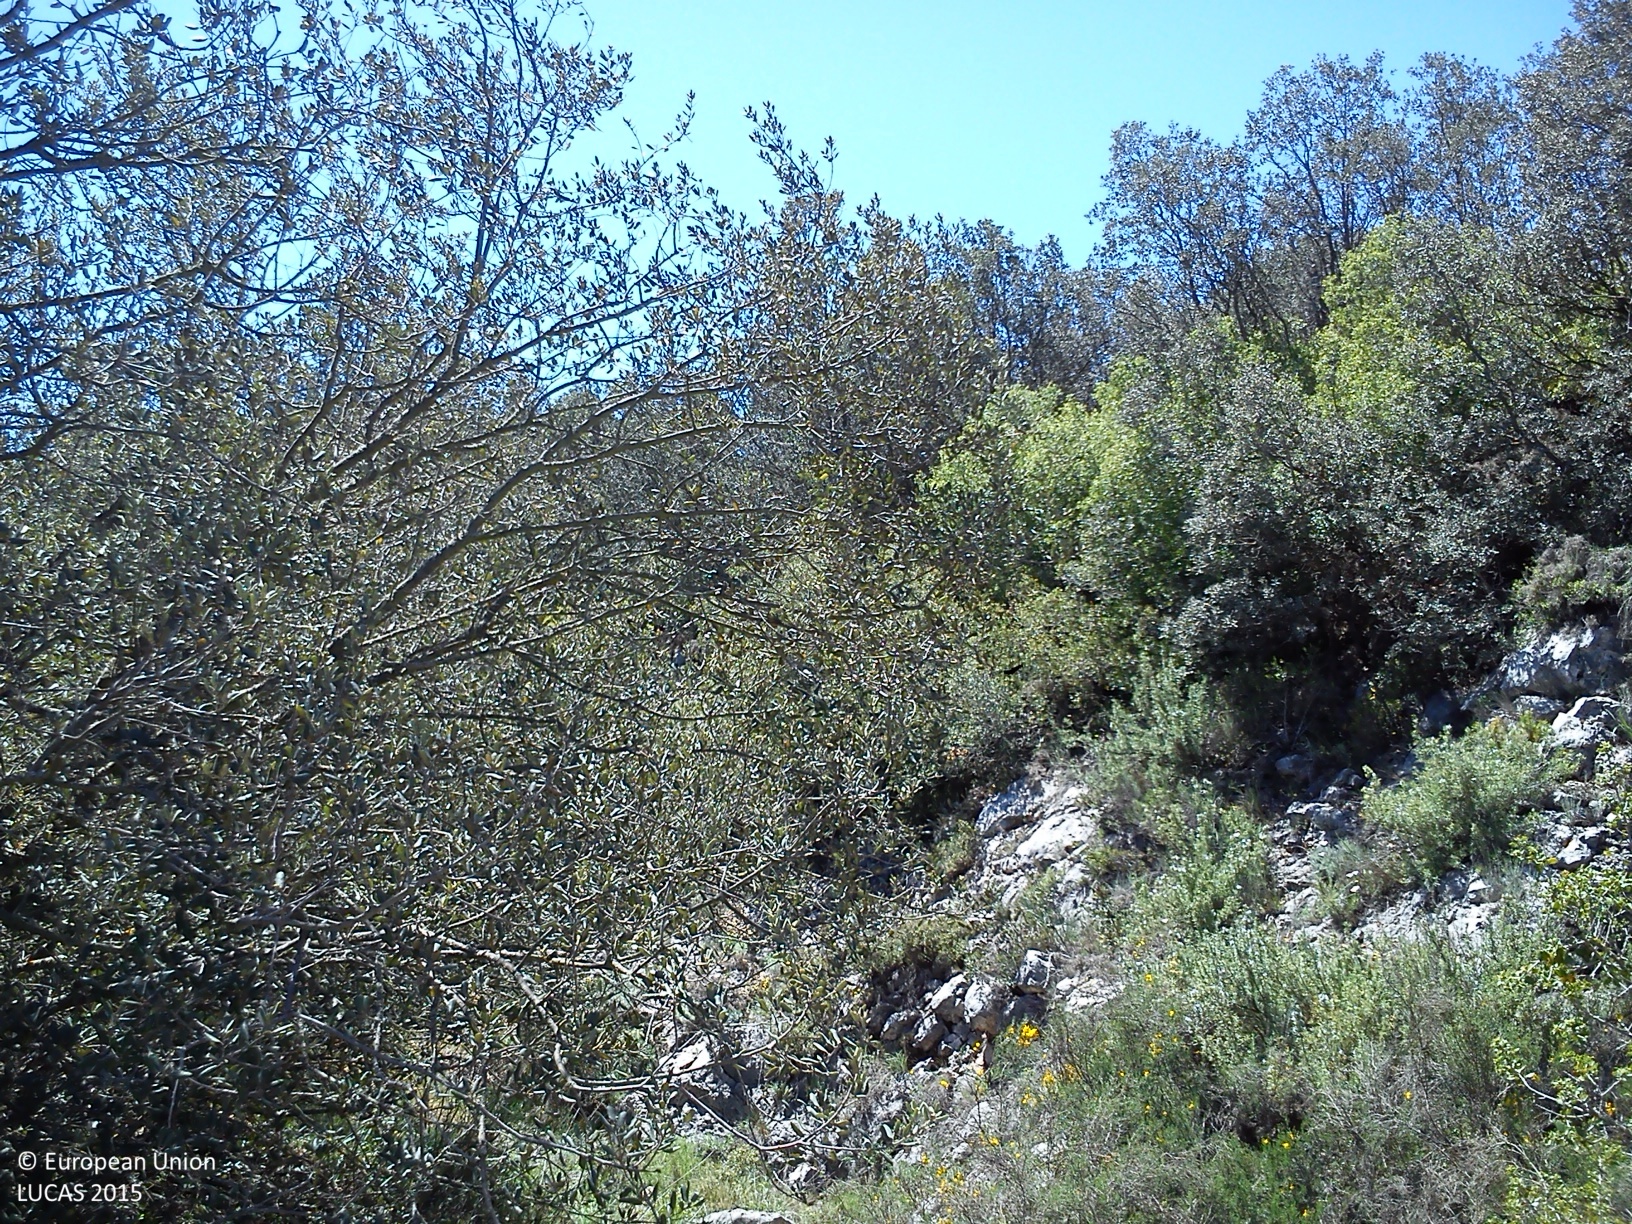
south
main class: Shrubland
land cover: Shrubland with sparse tree cover
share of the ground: > 75 %
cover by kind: shrubs 90 %, coniferous forest trees 5 %, consolidated bare surface 5 %
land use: Semi-natural and natural areas not in use
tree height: < 5 m
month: May
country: ES
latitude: 39.5328
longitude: -0.8787
